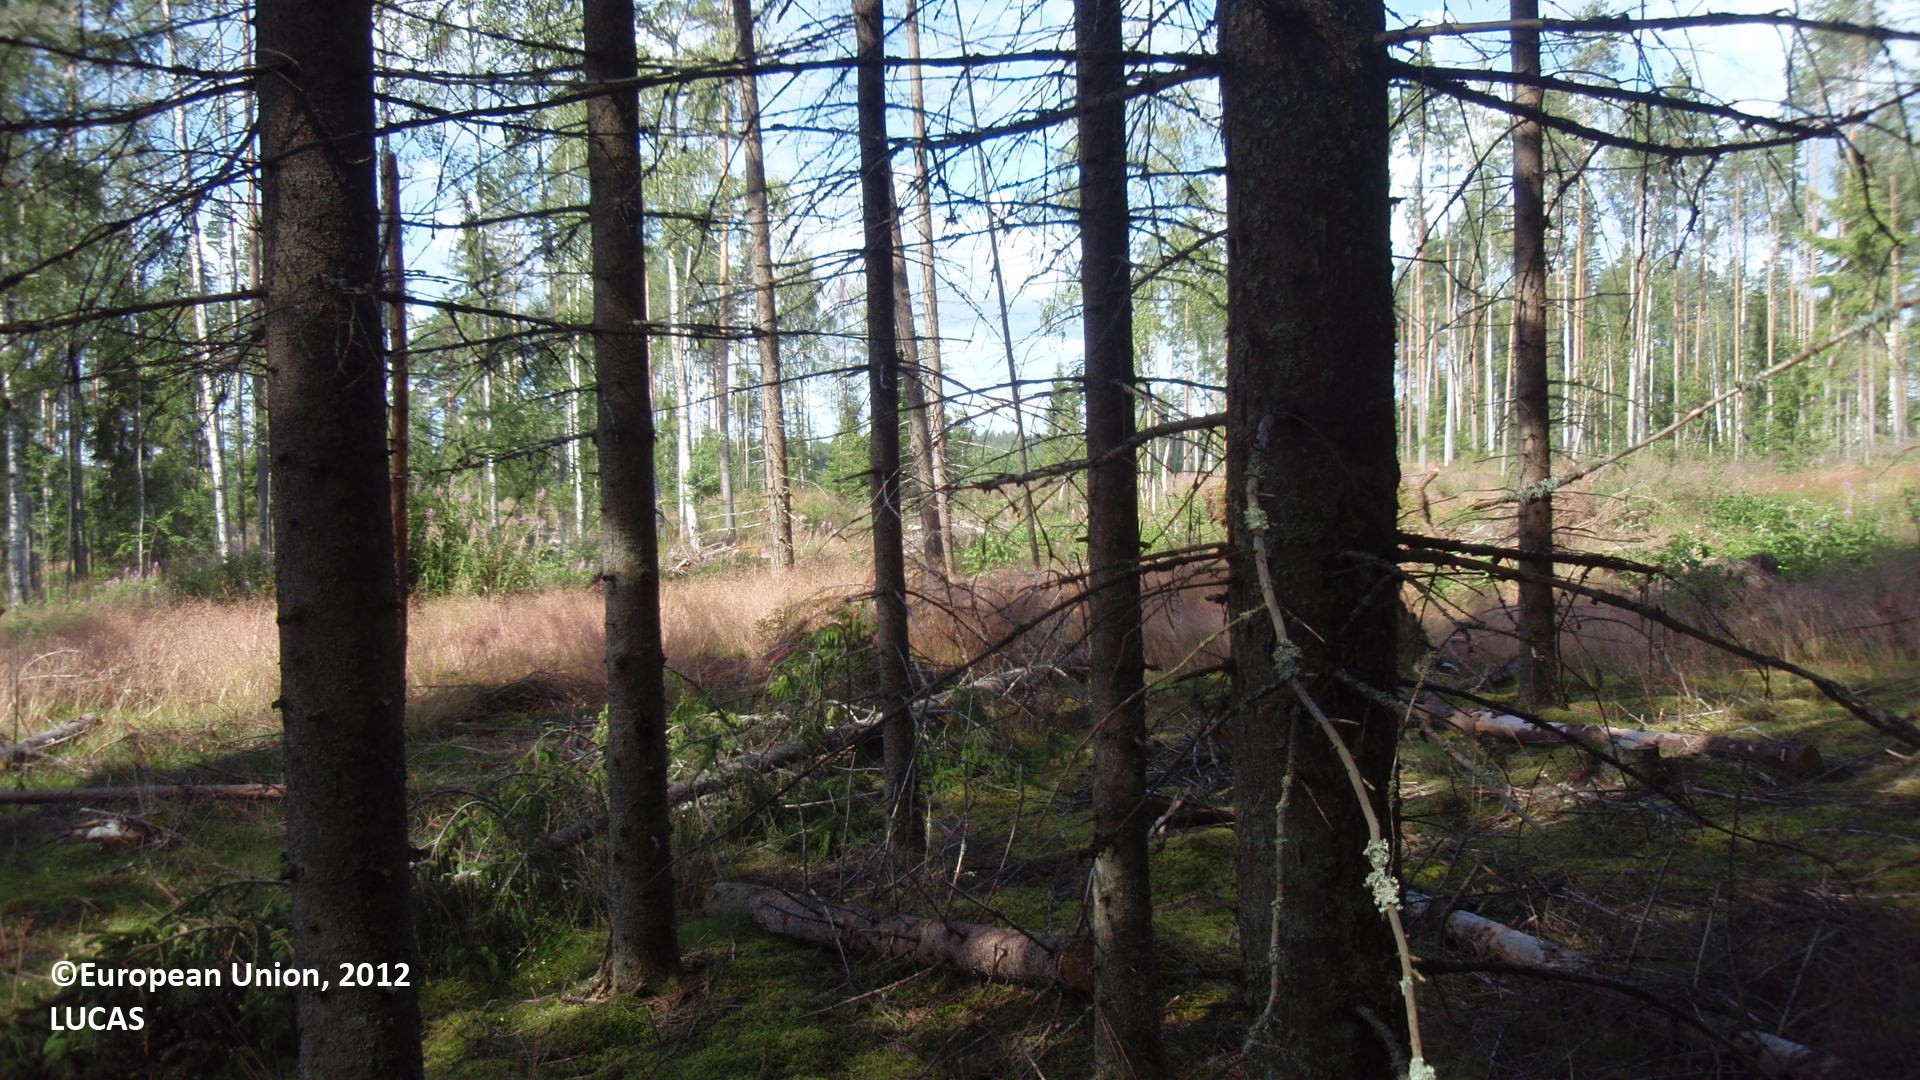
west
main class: Woodland
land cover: Spruce dominated coniferous woodland
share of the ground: 50 - 75 %
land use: Forestry
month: July
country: FI
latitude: 61.4294
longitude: 29.0722
